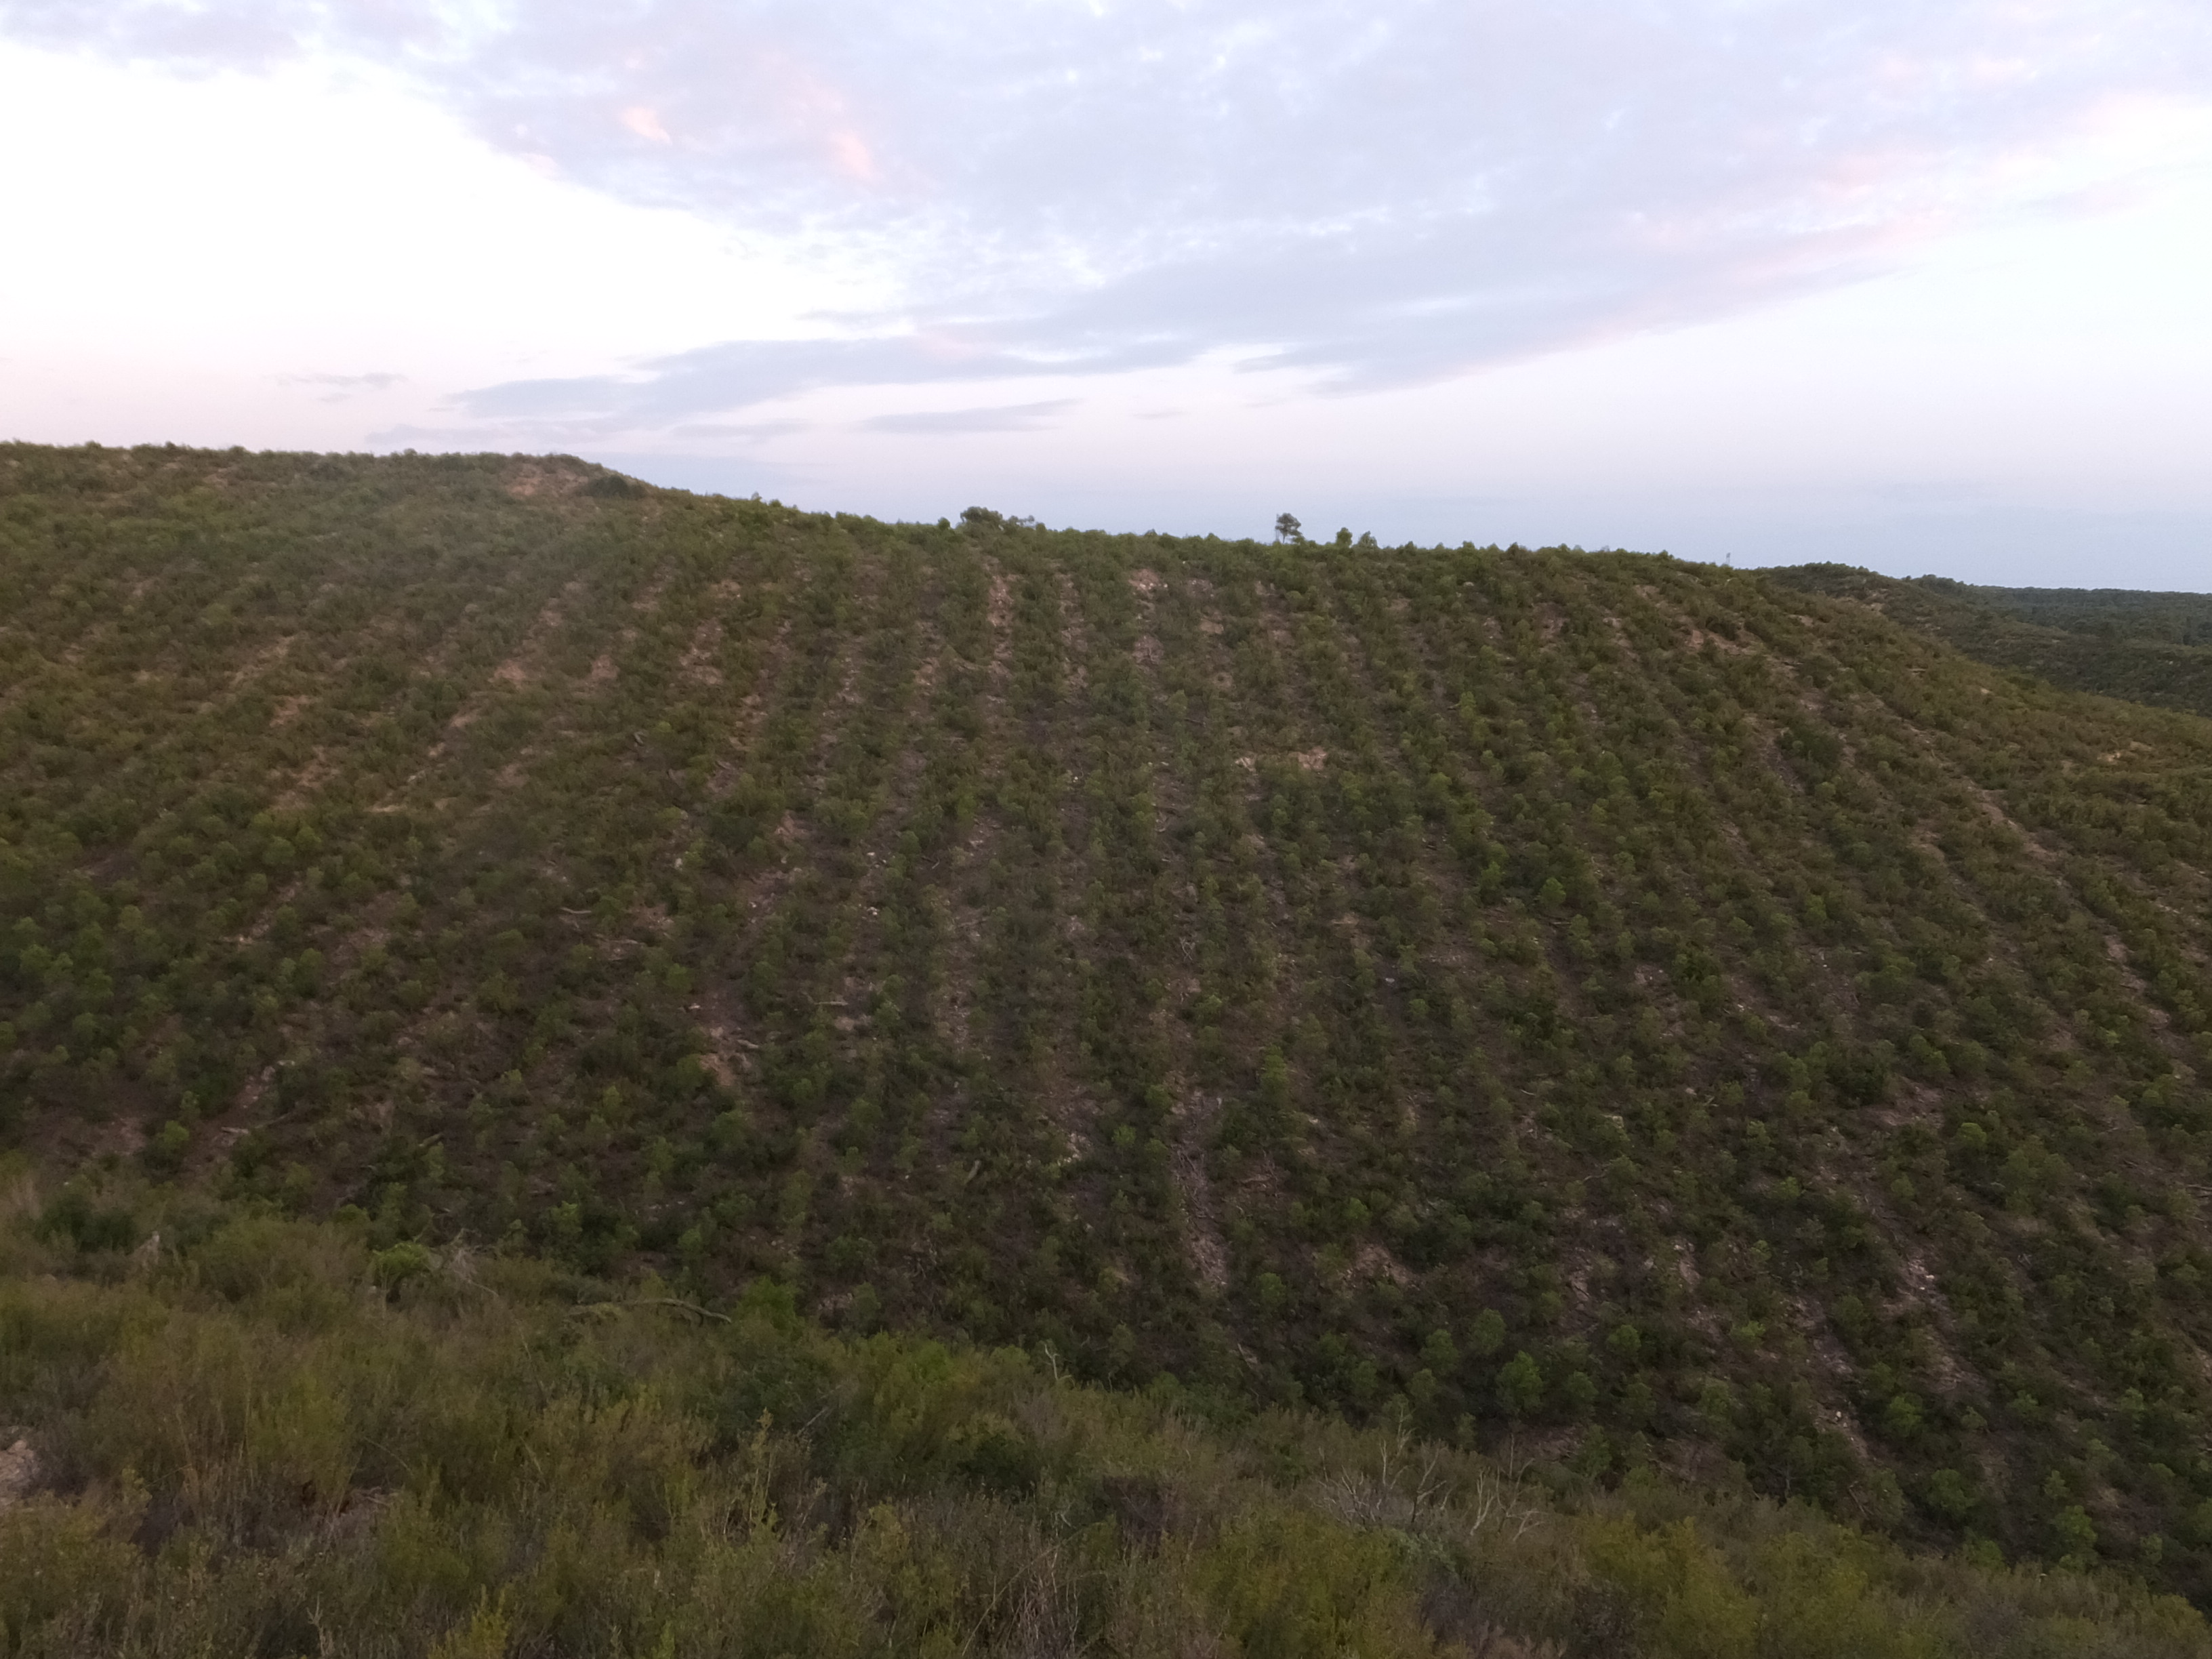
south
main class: Shrubland
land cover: Shrubland without tree cover
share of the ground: > 75 %
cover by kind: shrubs 70 %, herbaceous plants 30 %
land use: Semi-natural and natural areas not in use
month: July
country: ES
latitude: 41.1869
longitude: 0.2969
